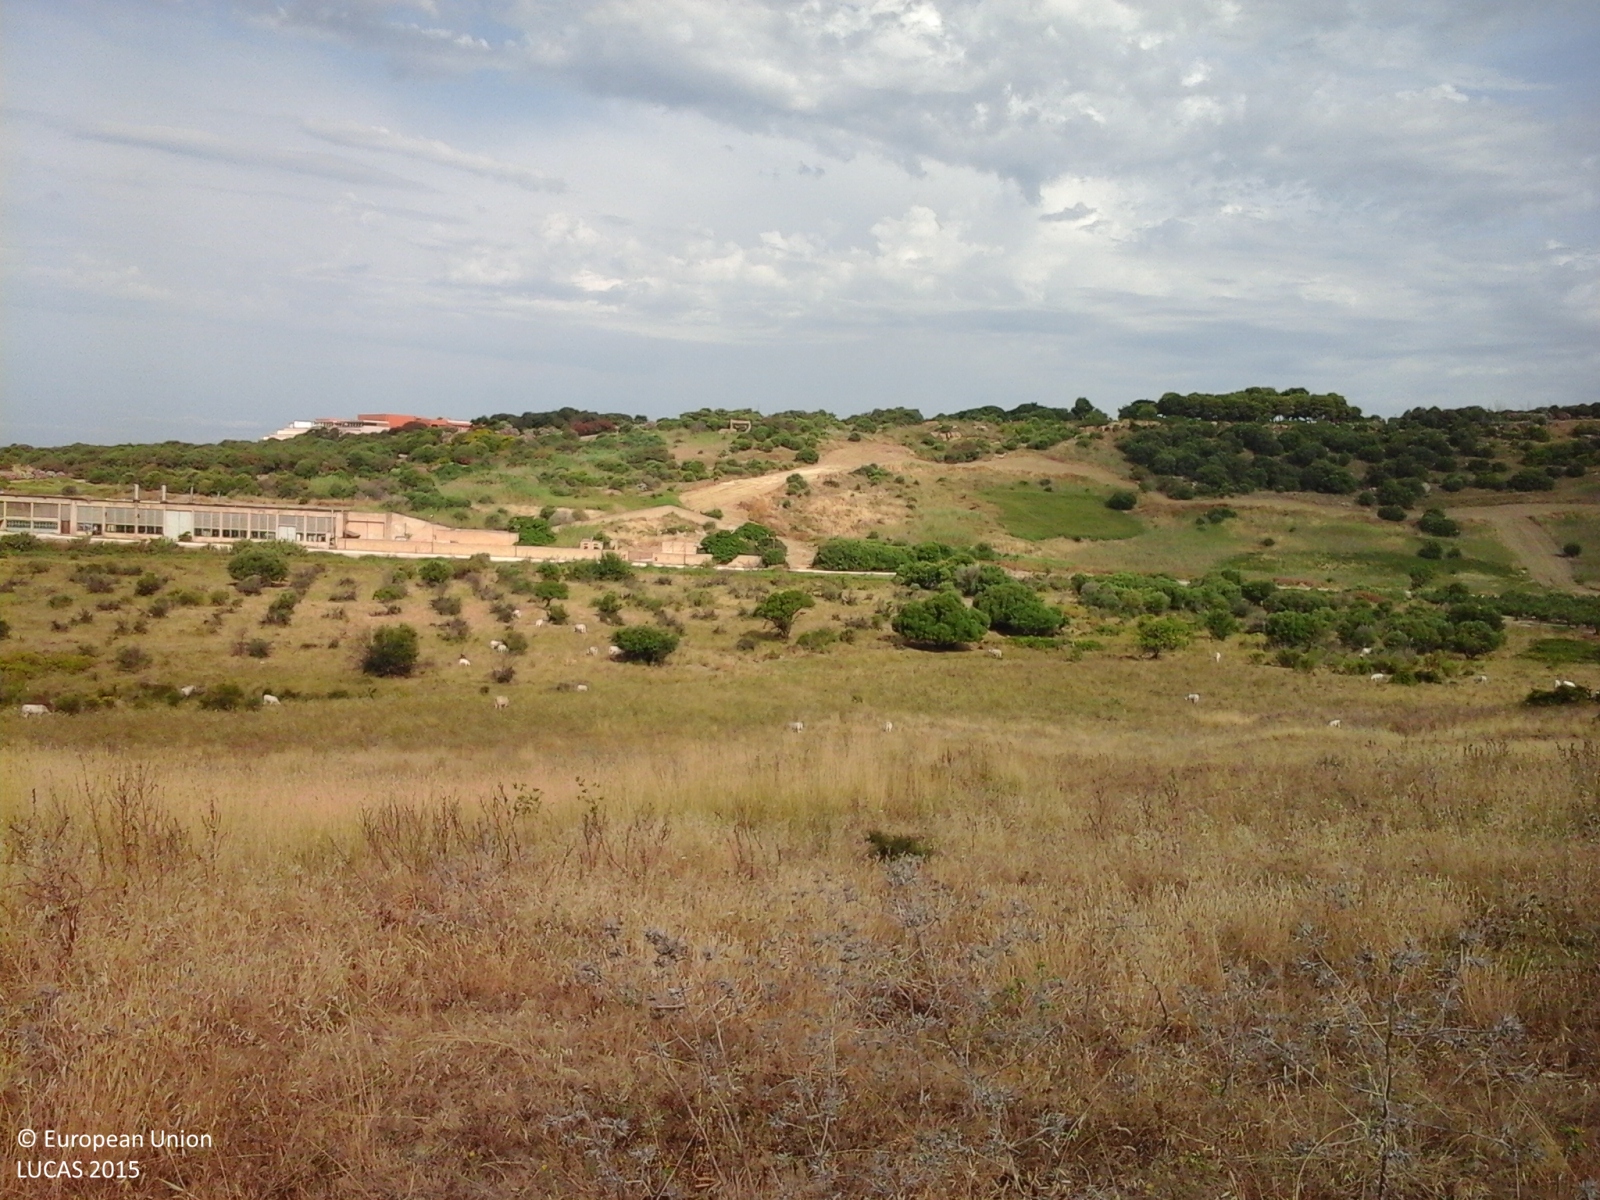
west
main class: Grassland
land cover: Grassland without tree/shrub cover
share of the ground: > 75 %
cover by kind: herbaceous plants 100 %
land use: Agriculture (excluding fallow land and kitchen gardens)
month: June
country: IT
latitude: 37.4961
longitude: 13.1317
